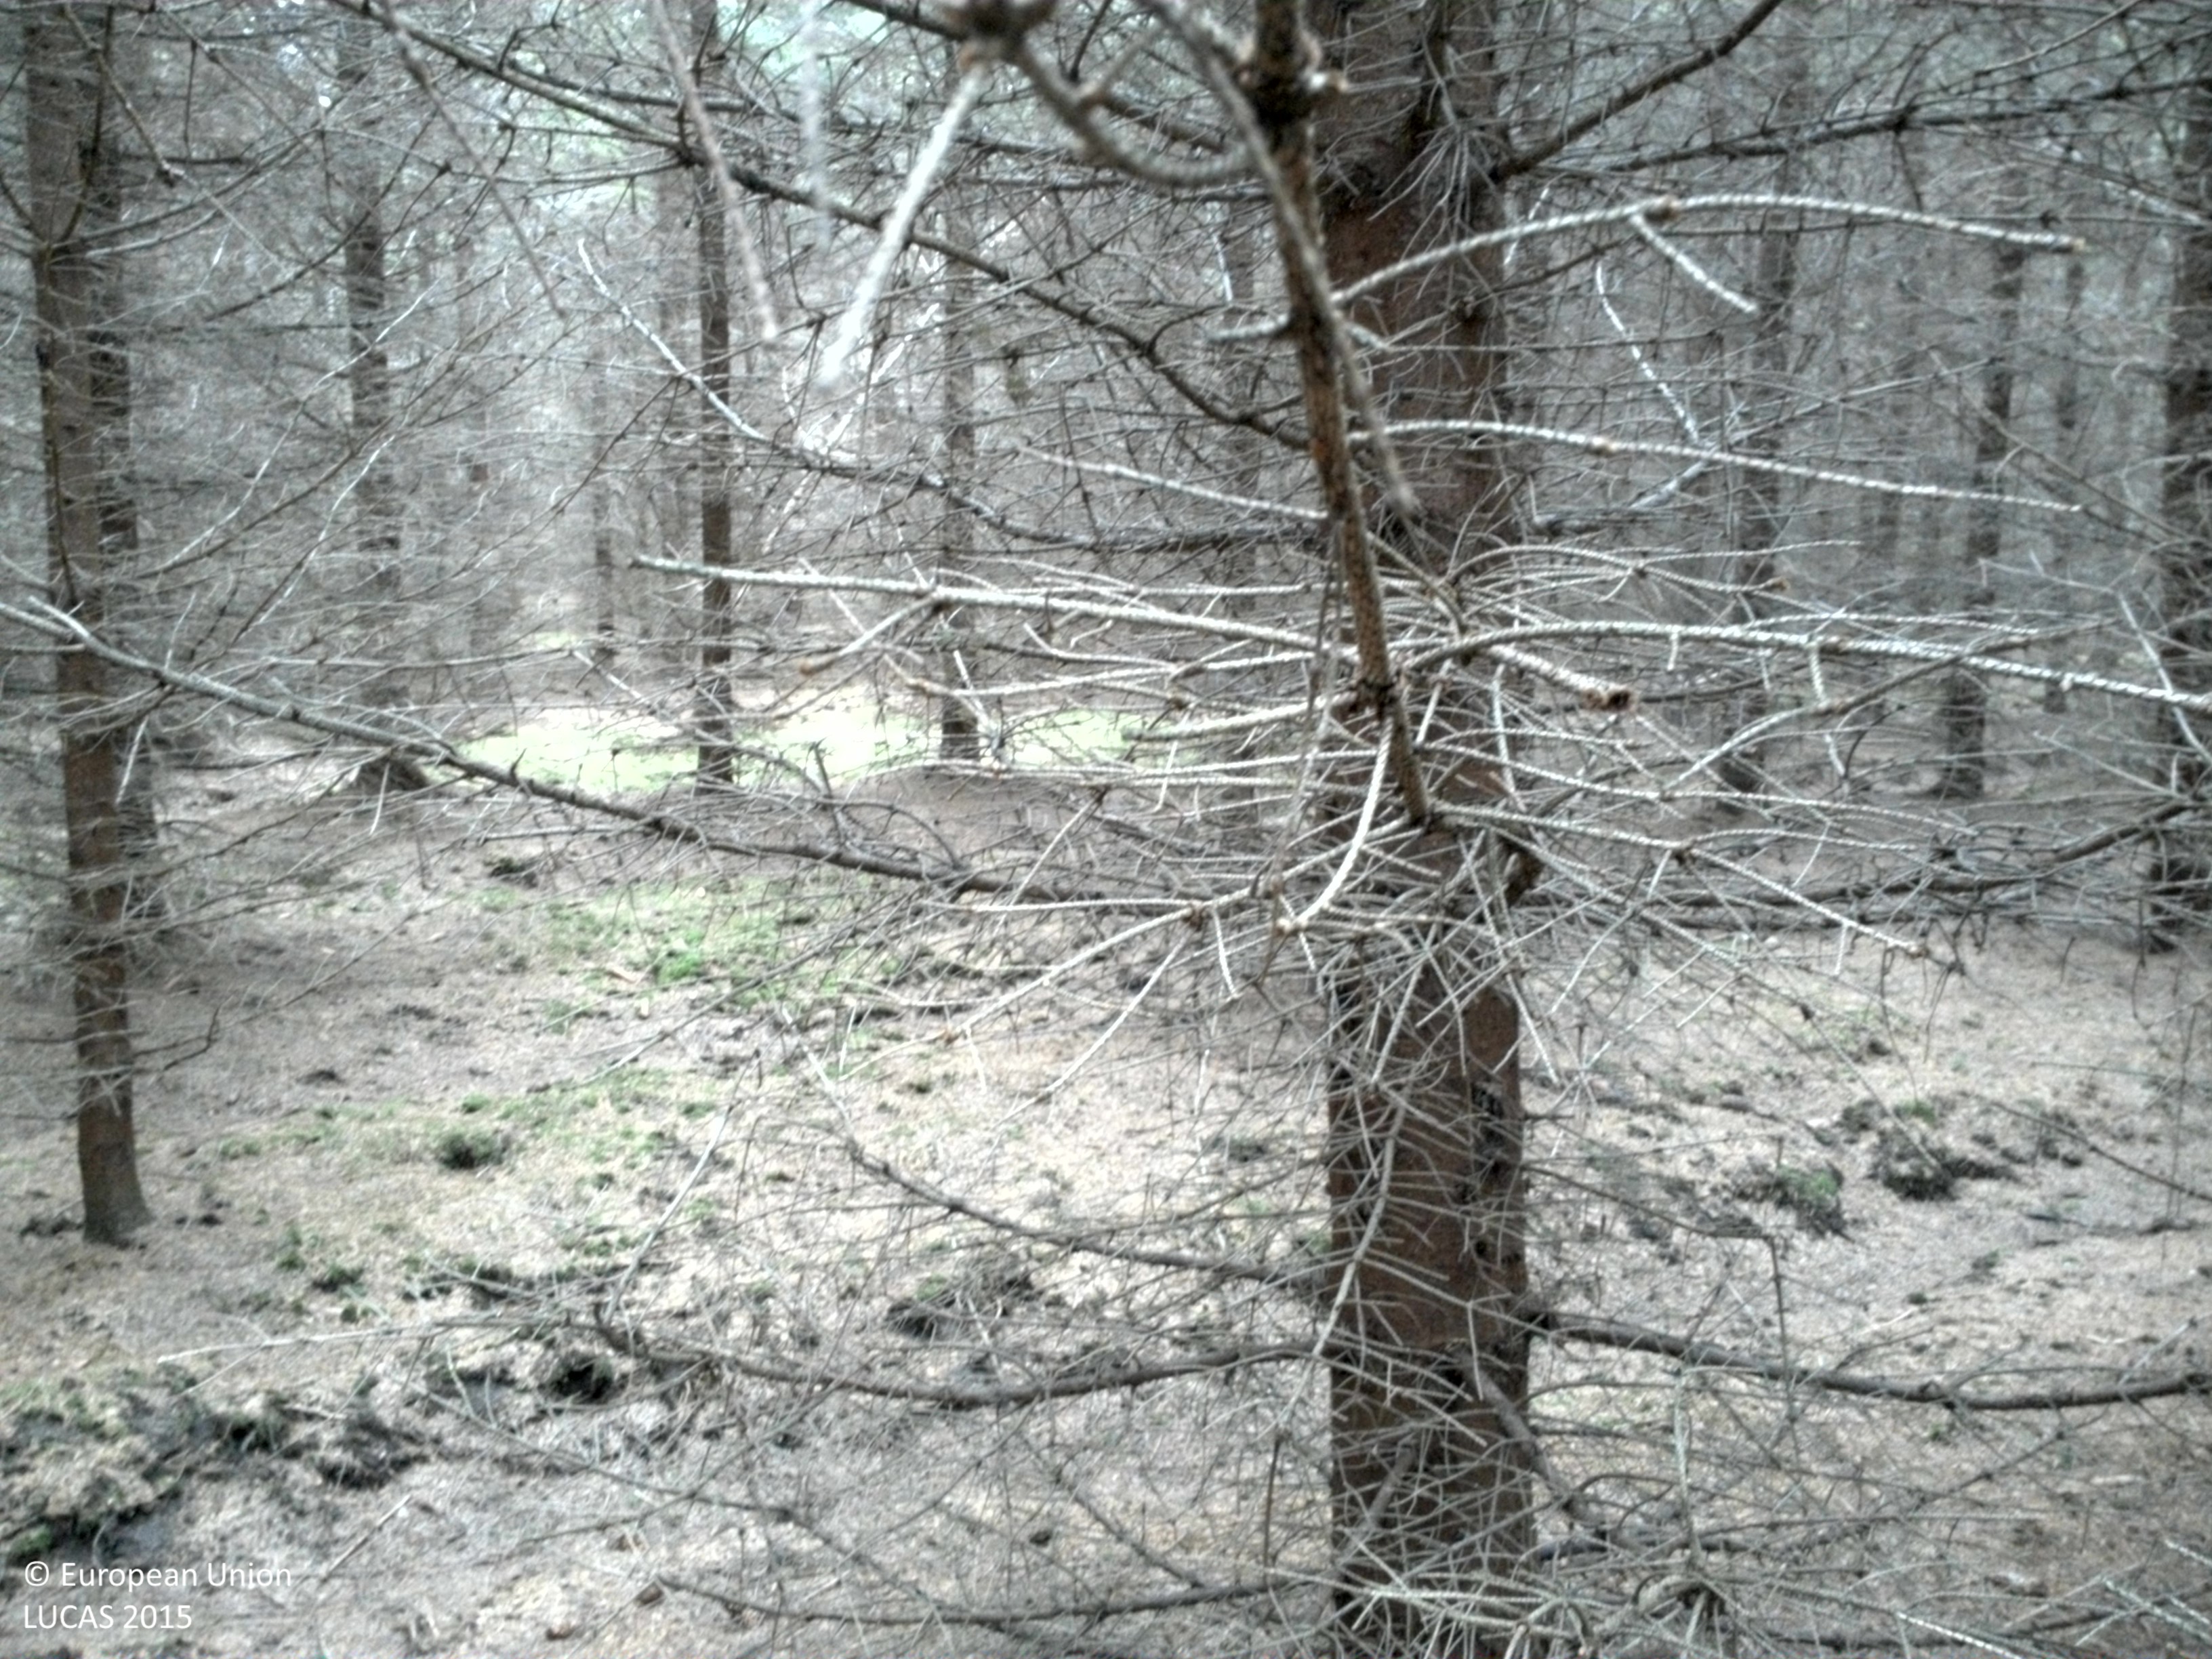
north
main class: Woodland
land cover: Spruce dominated coniferous woodland
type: boreal forest
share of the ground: > 75 %
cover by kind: coniferous forest trees 100 %
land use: Forestry
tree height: > 5 m
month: May
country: SE
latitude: 59.2545
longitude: 14.1481
